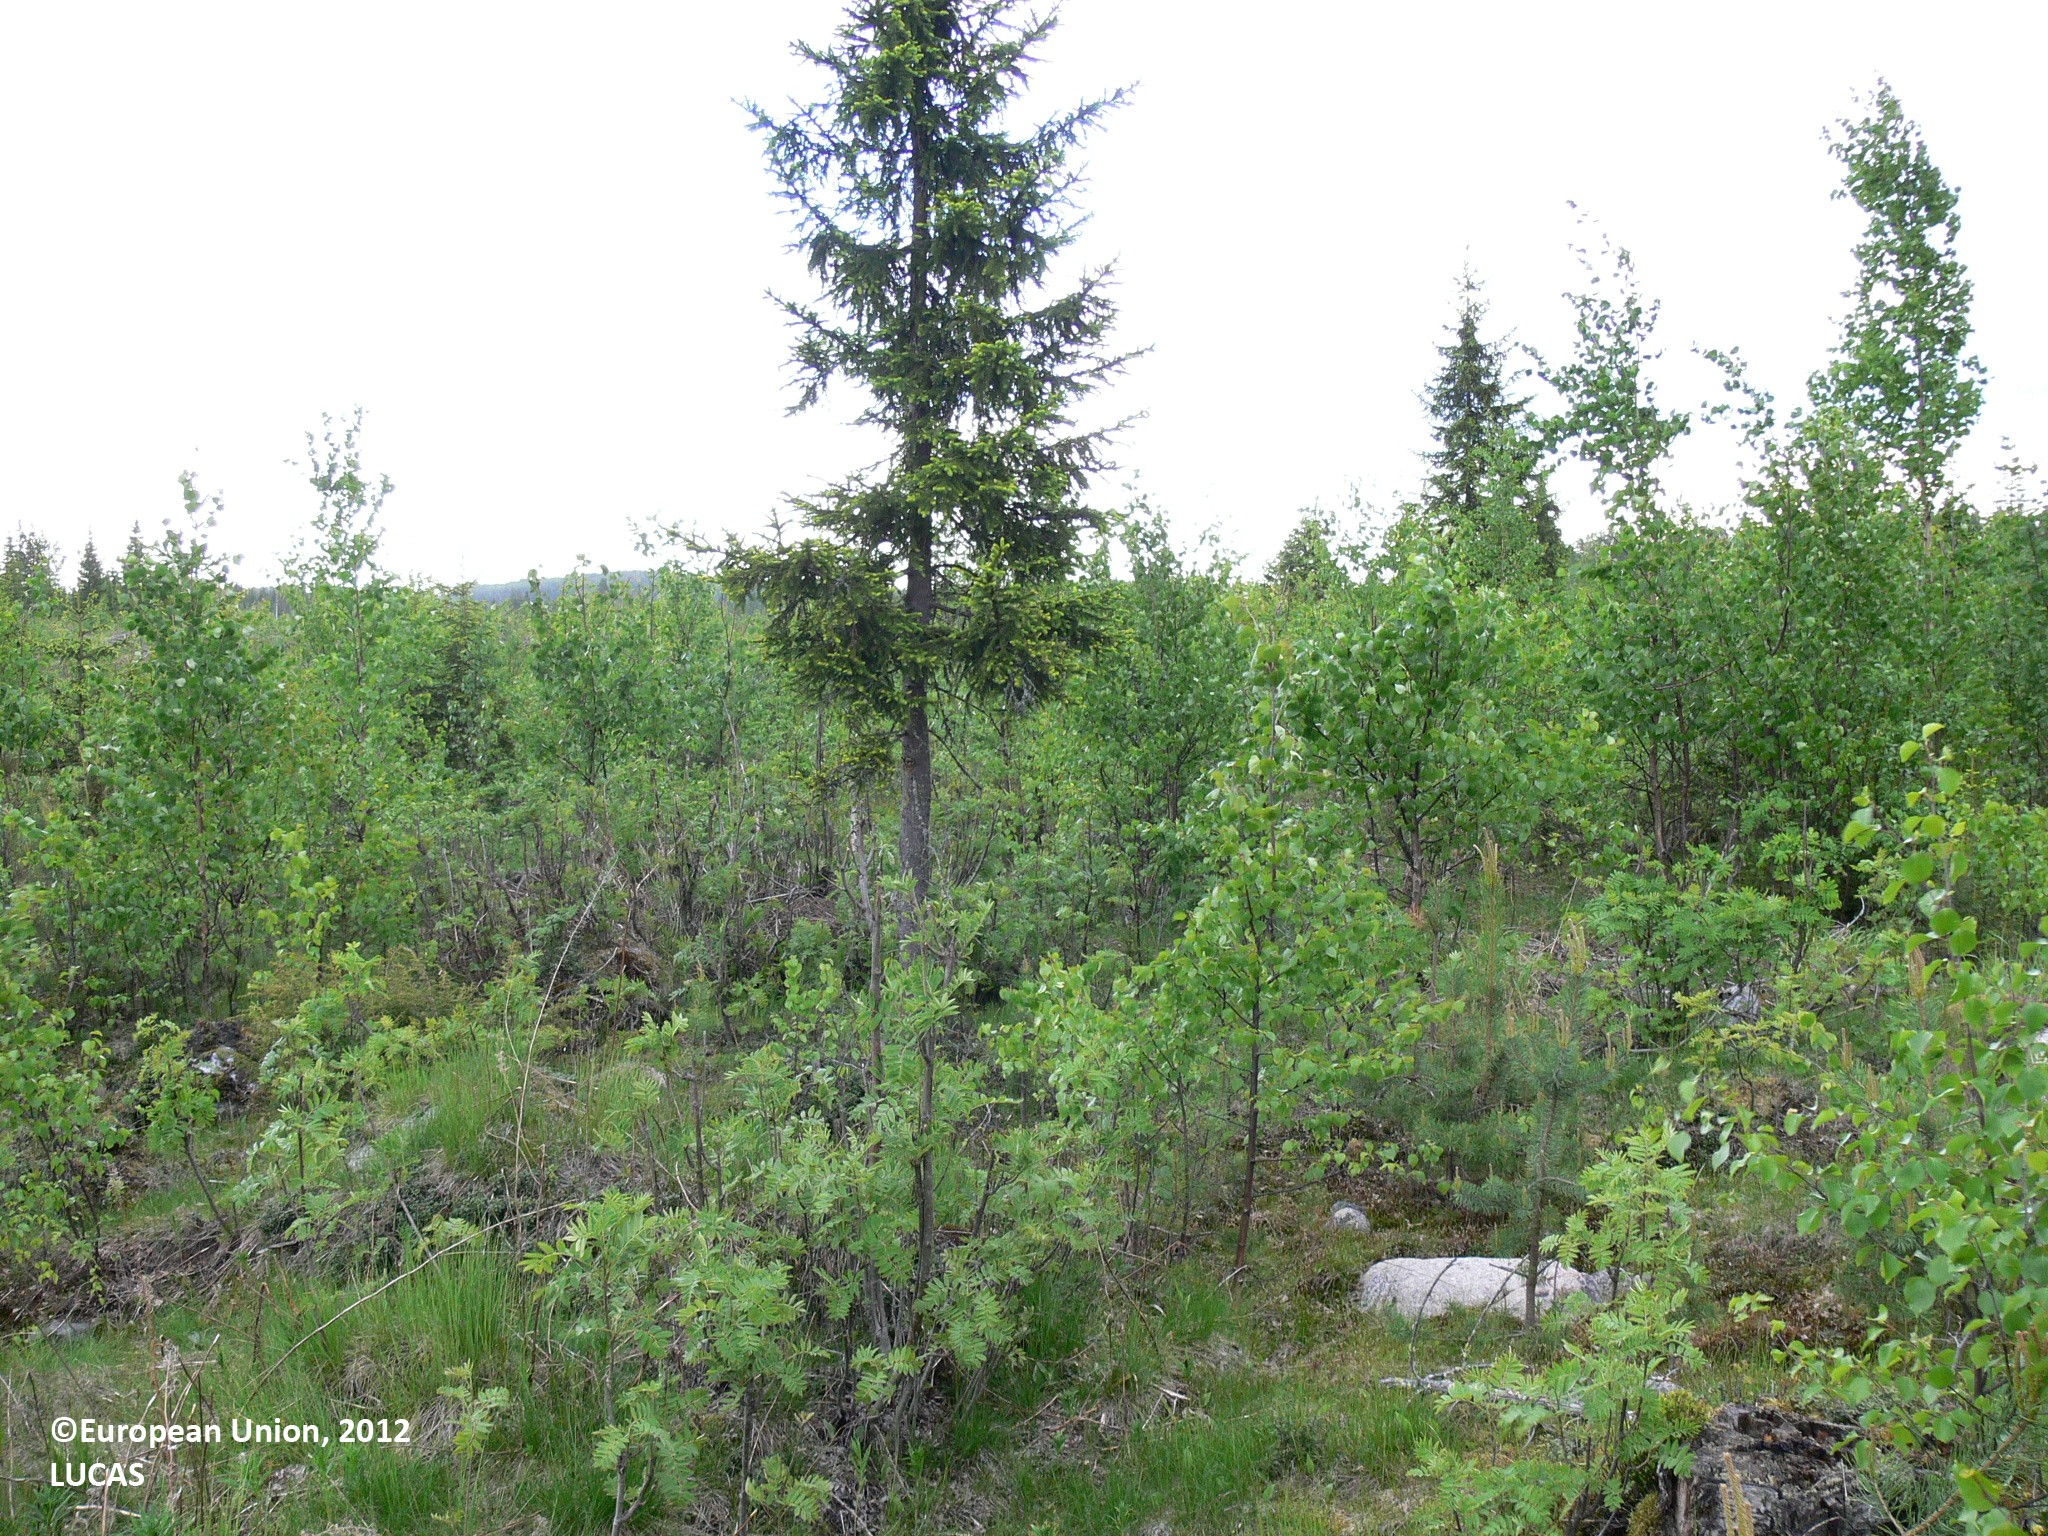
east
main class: Woodland
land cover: Other mixed woodland
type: boreal forest
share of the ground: 25 - 50 %
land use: Forestry
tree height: < 5 m
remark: Clear cut
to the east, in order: Other mixed woodland
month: June
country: FI
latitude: 62.6415
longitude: 30.3444
